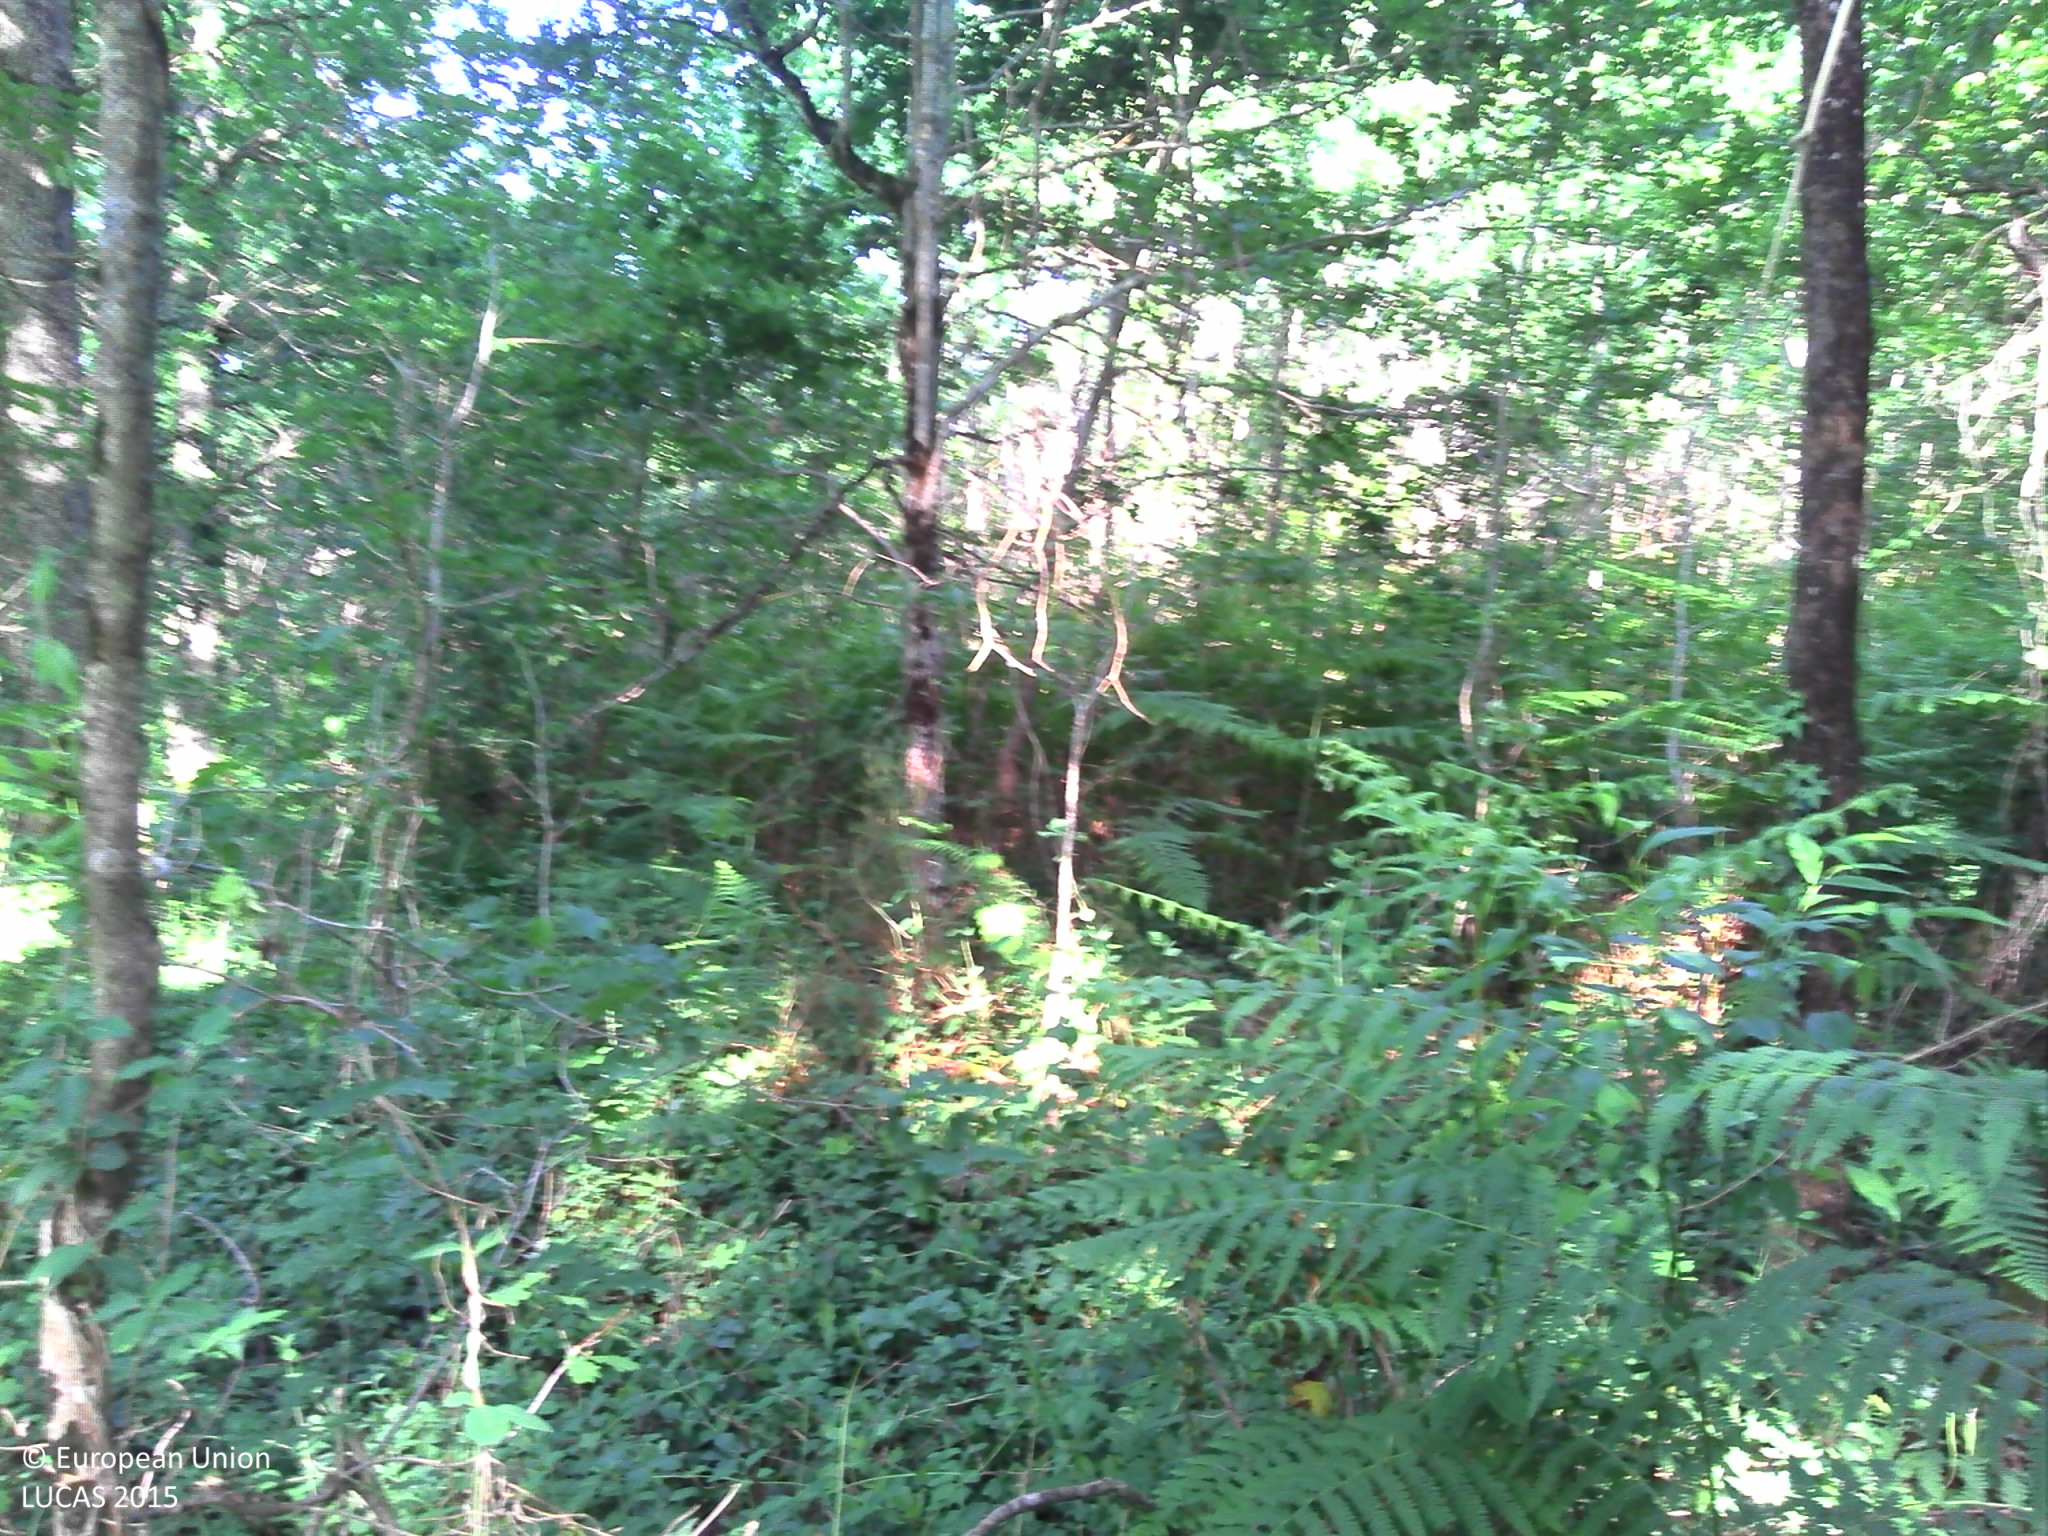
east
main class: Woodland
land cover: Broadleaved woodland
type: acidophilous oak and oak-birch forest
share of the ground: > 75 %
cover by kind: broadleaved forest trees 85 %, herbaceous plants 10 %, shrubs 5 %
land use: Forestry
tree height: > 5 m
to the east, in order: Broadleaved woodland
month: June
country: FR
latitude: 46.9308
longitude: 0.1666
